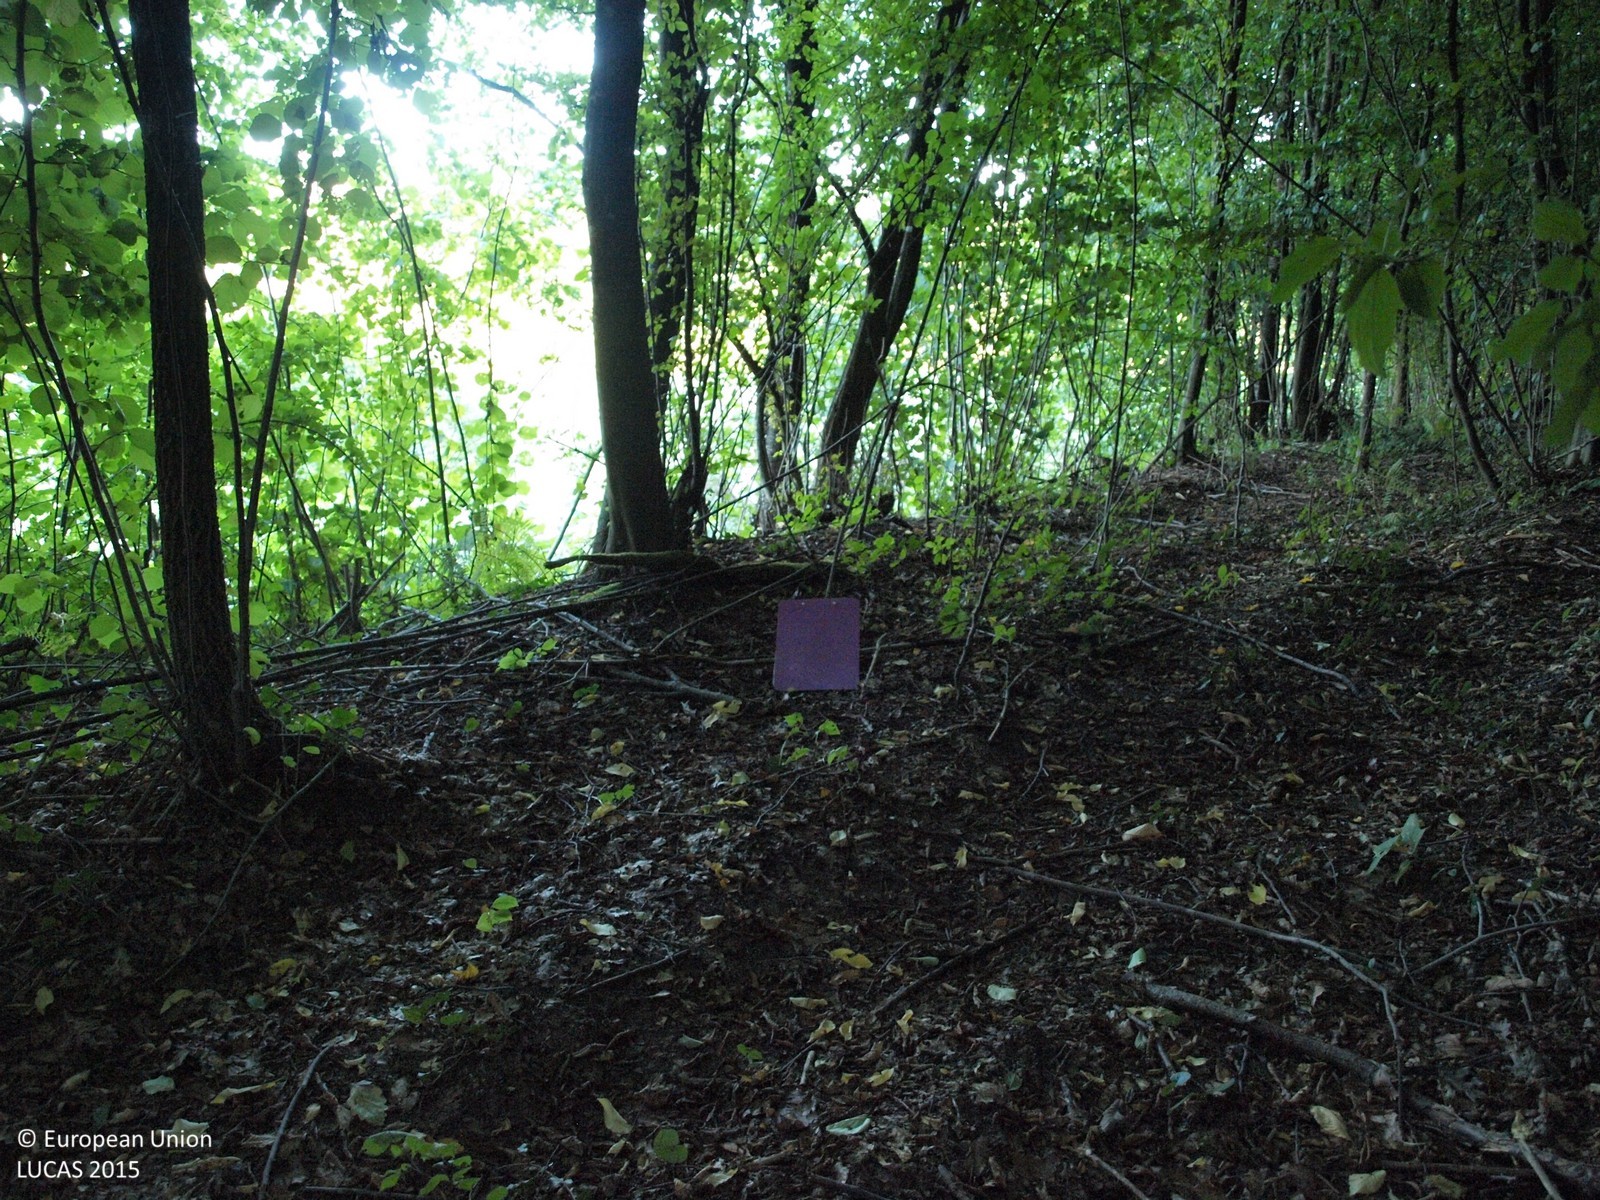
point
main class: Woodland
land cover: Broadleaved woodland
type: beech forest
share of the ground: > 75 %
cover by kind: broadleaved forest trees 100 %
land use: Forestry
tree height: > 5 m
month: August
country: HR
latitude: 46.0941
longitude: 16.5838
